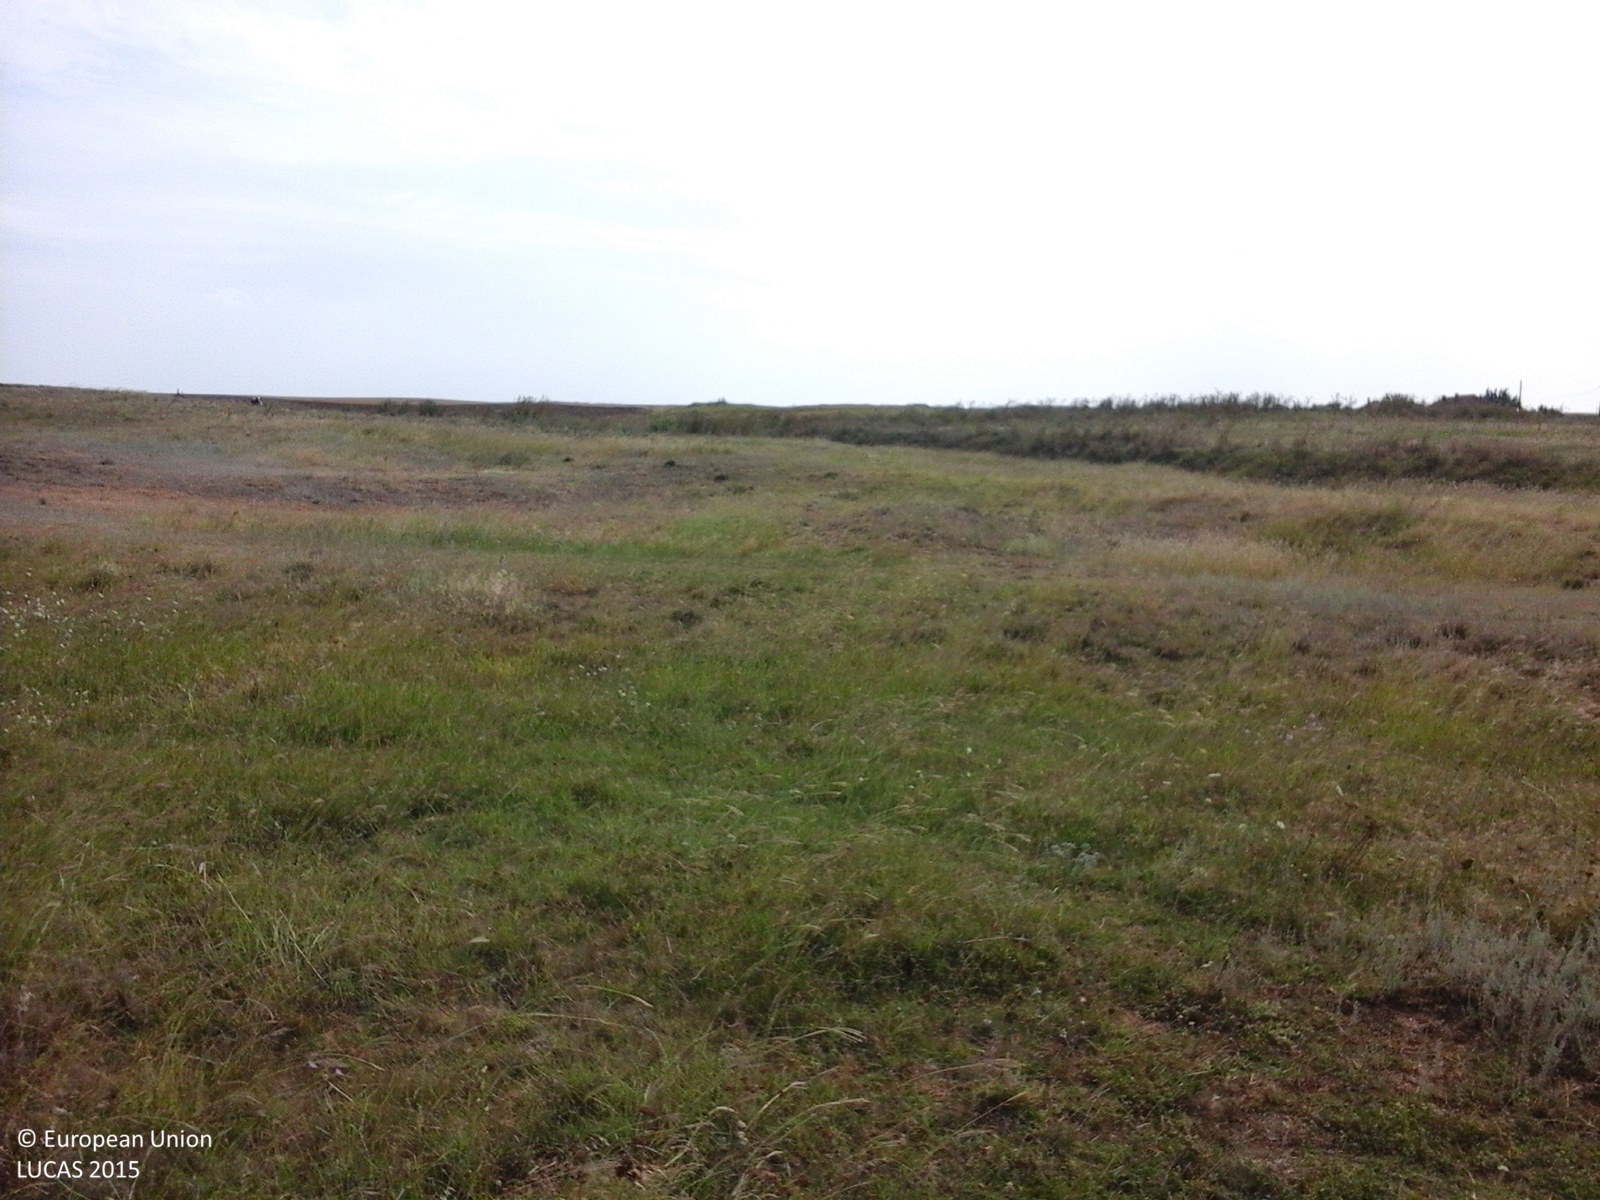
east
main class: Grassland
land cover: Grassland without tree/shrub cover
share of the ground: > 75 %
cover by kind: herbaceous plants 100 %
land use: Agriculture (excluding fallow land and kitchen gardens)
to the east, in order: Grassland without tree/shrub cover; Ditches and canals; Spontaneously vegetated surfaces; Common wheat; Lucerne
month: August
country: RO
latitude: 44.7240
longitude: 28.5741
